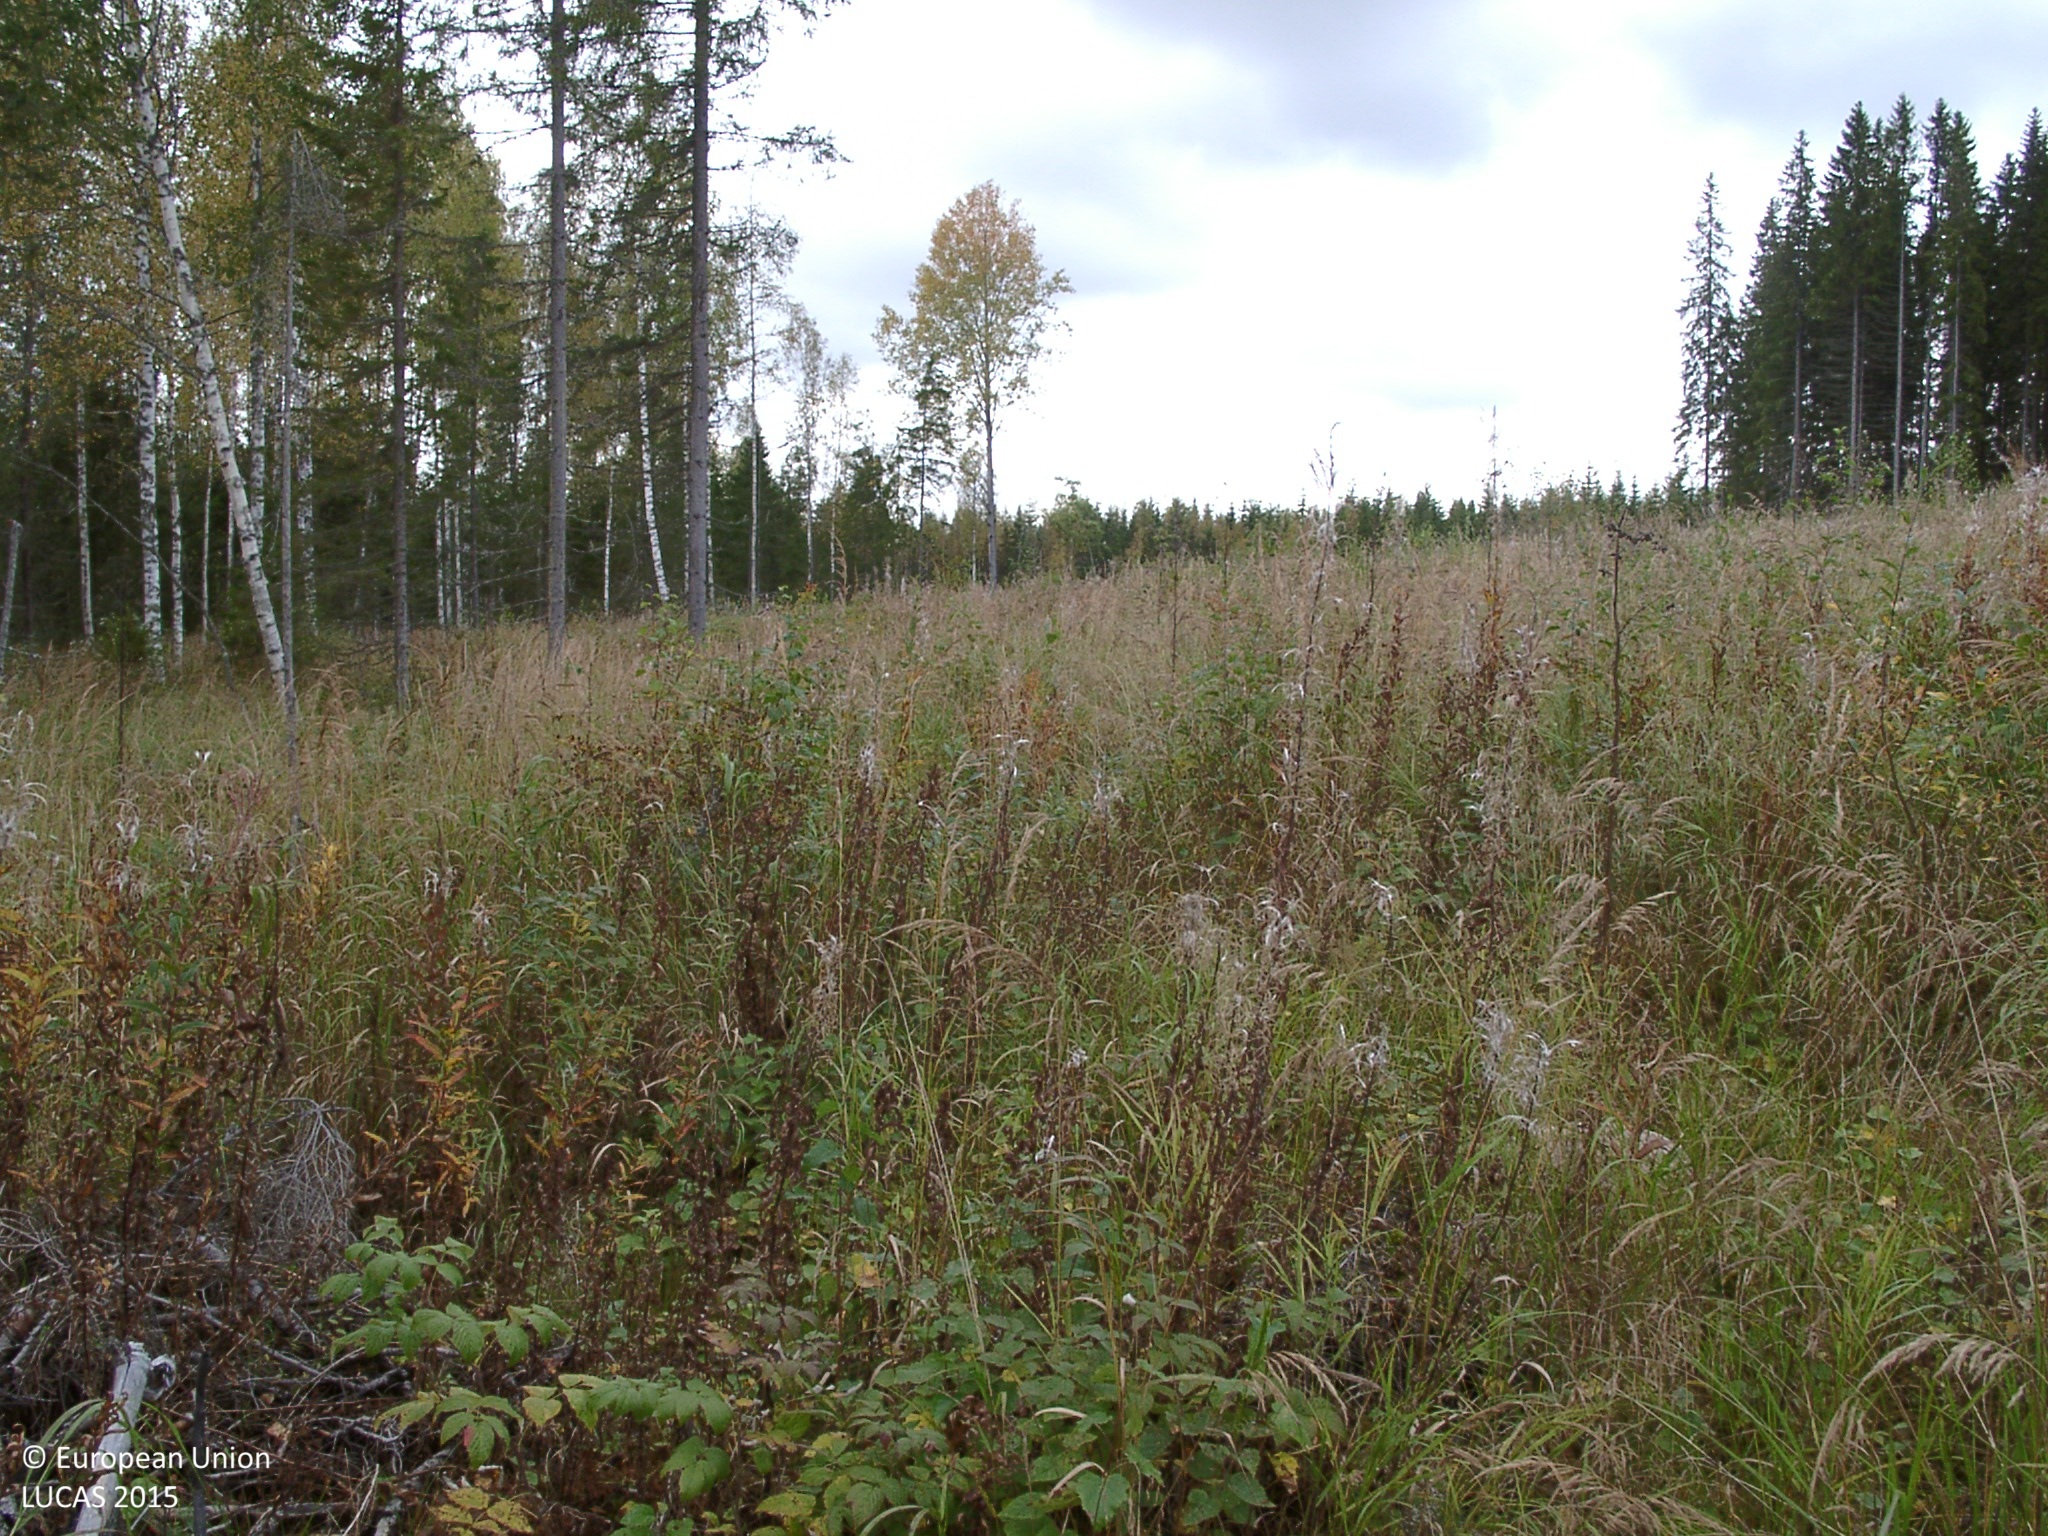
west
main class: Woodland
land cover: Broadleaved woodland
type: boreal forest
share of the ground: 10 - 25 %
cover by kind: herbaceous plants 85 %, broadleaved forest trees 10 %, shrubs 5 %
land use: Forestry
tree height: < 5 m
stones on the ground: < 10 %
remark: Clear cut
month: September
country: FI
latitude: 62.8796
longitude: 25.7861
